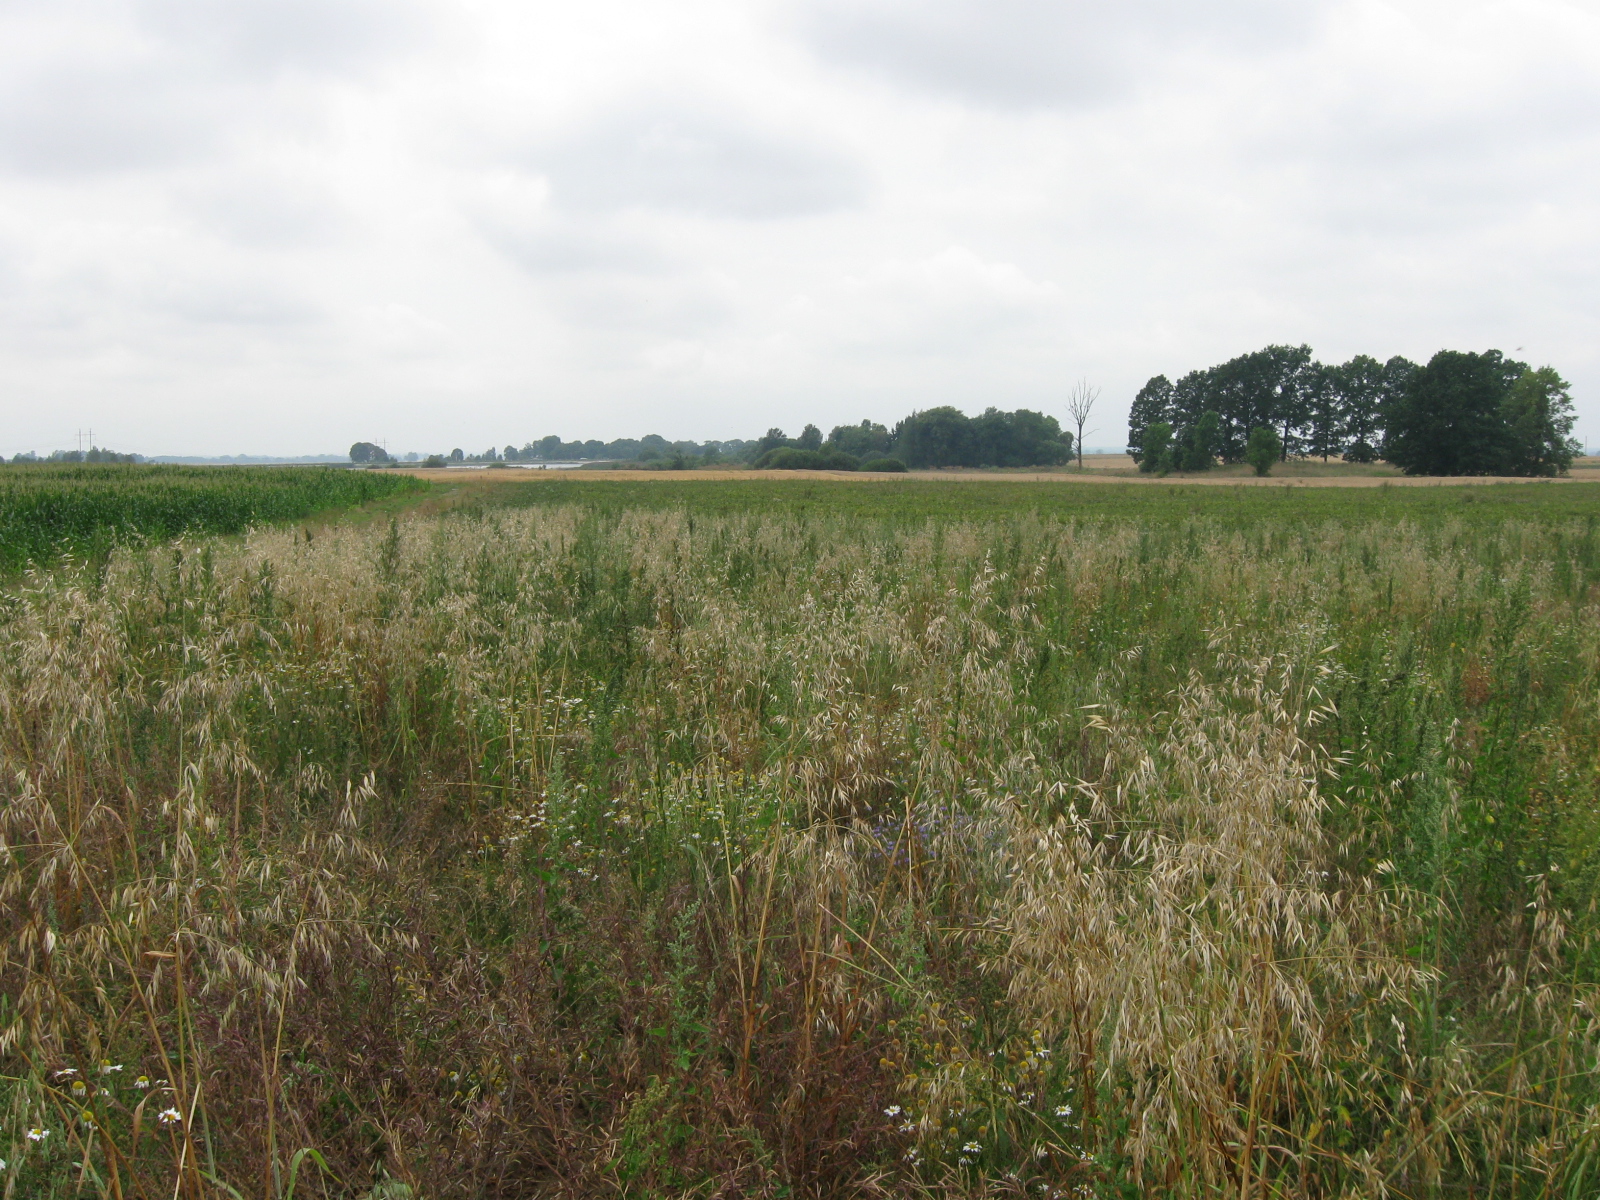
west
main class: Cropland
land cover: Common wheat
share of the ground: > 75 %
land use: Agriculture (excluding fallow land and kitchen gardens)
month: August
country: LT
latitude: 54.6113
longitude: 23.5060
